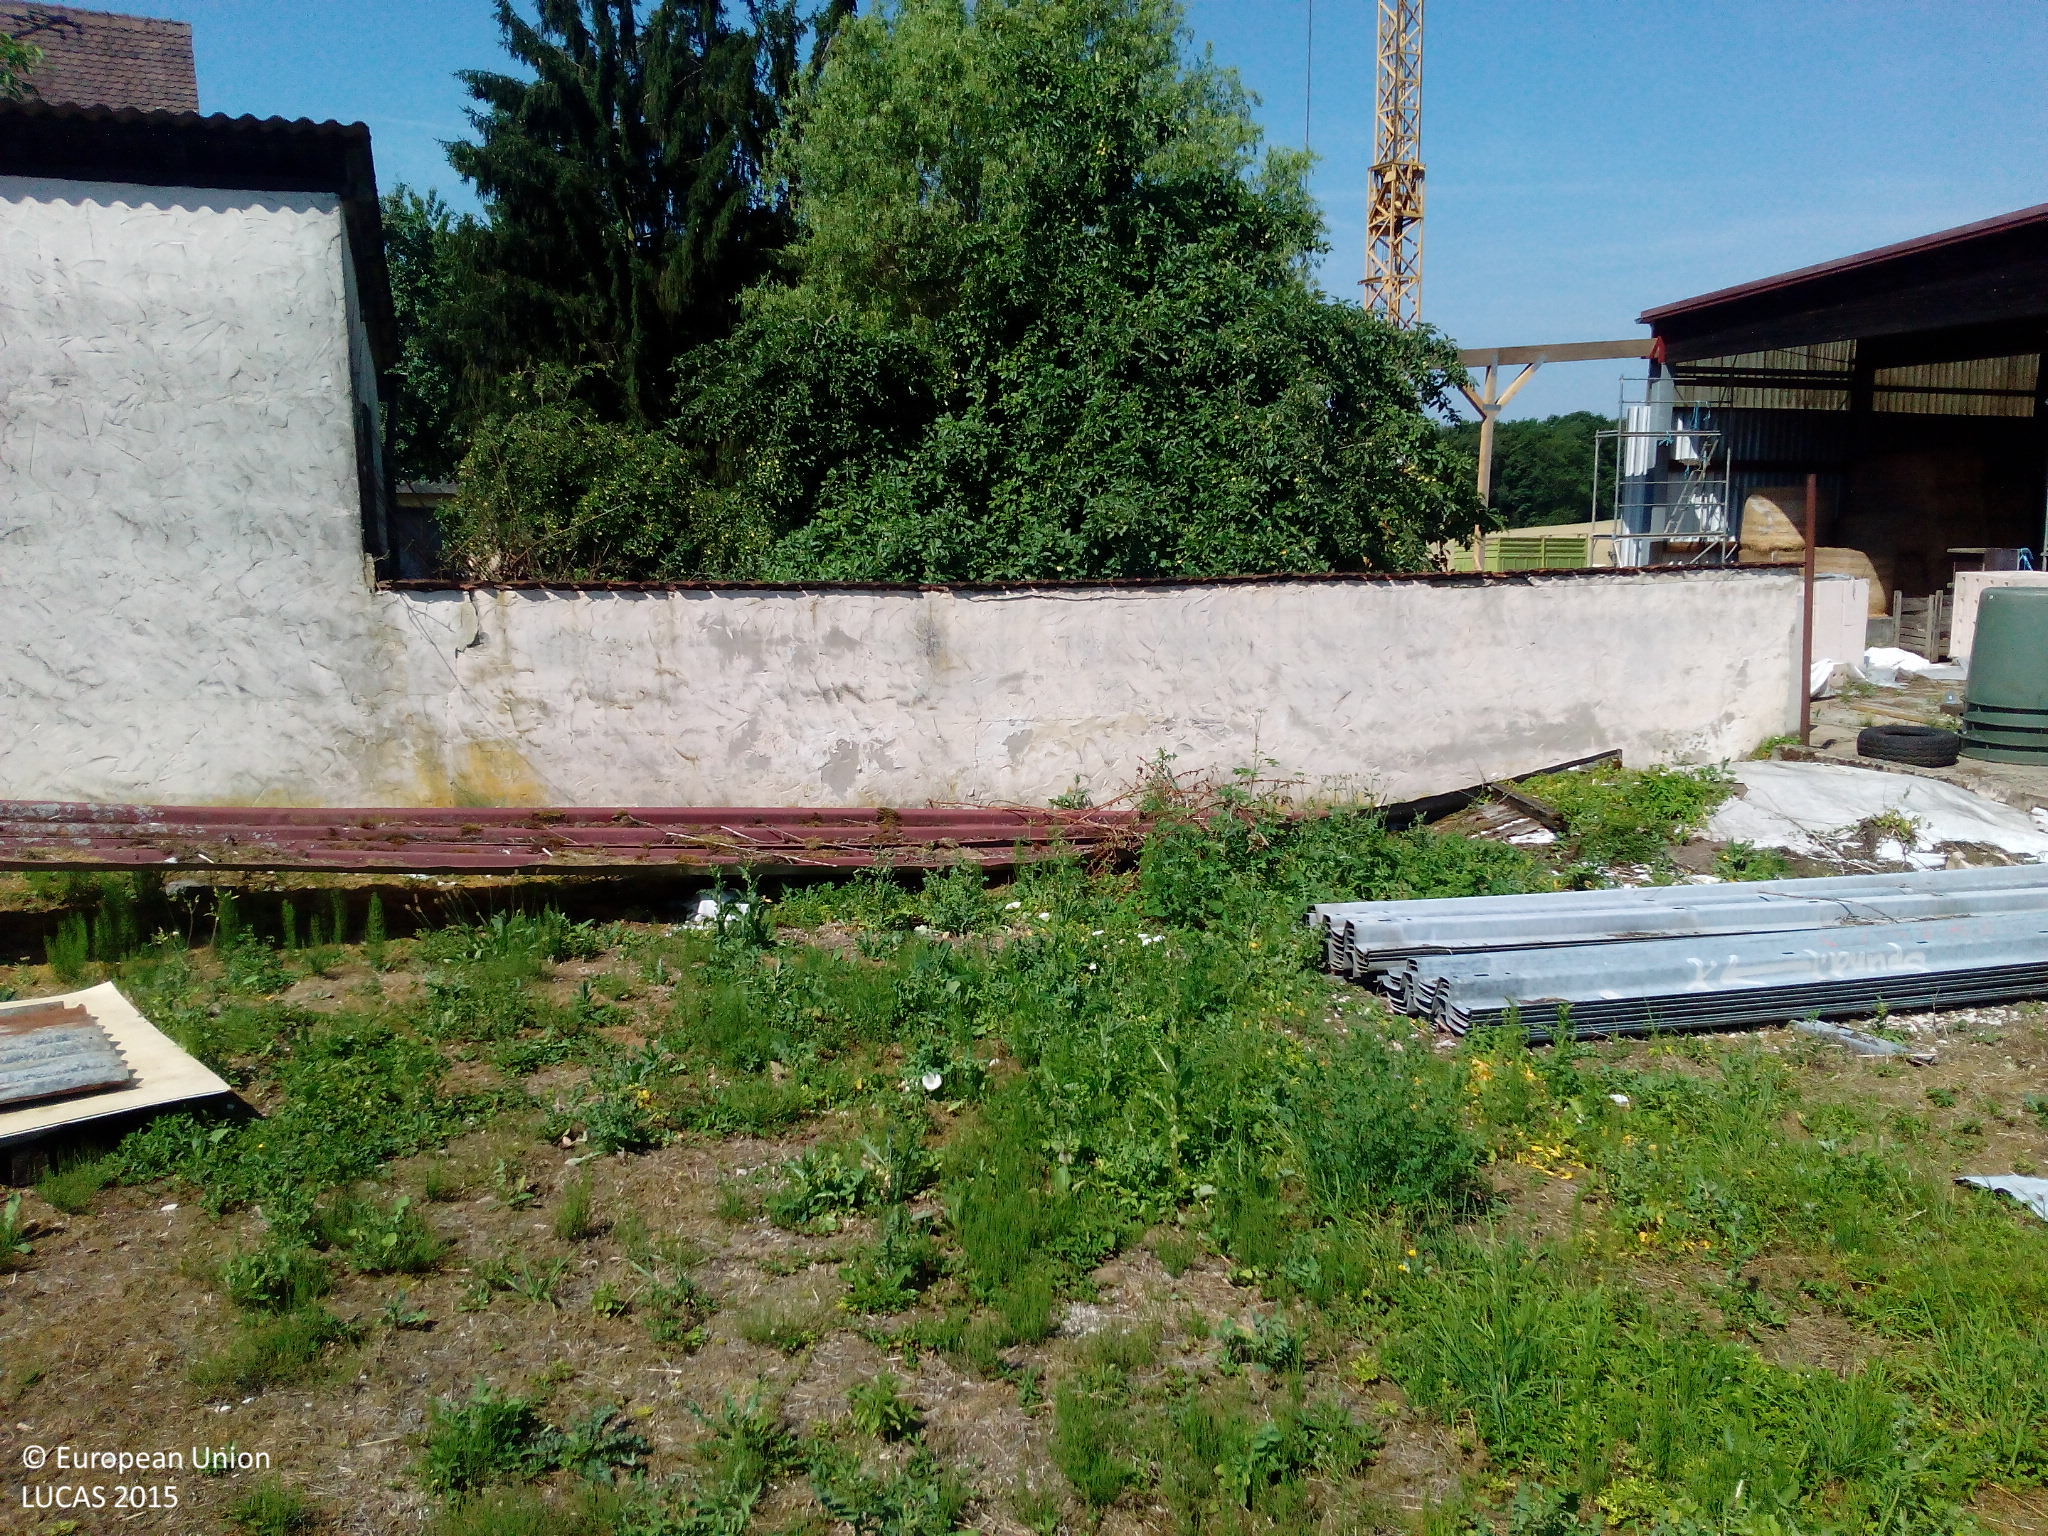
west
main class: Grassland
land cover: Spontaneously vegetated surfaces
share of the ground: > 75 %
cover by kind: herbaceous plants 55 %, unconsolidated bare surface 45 %
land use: Logistics and storage
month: July
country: DE
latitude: 49.7836
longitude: 11.0691
